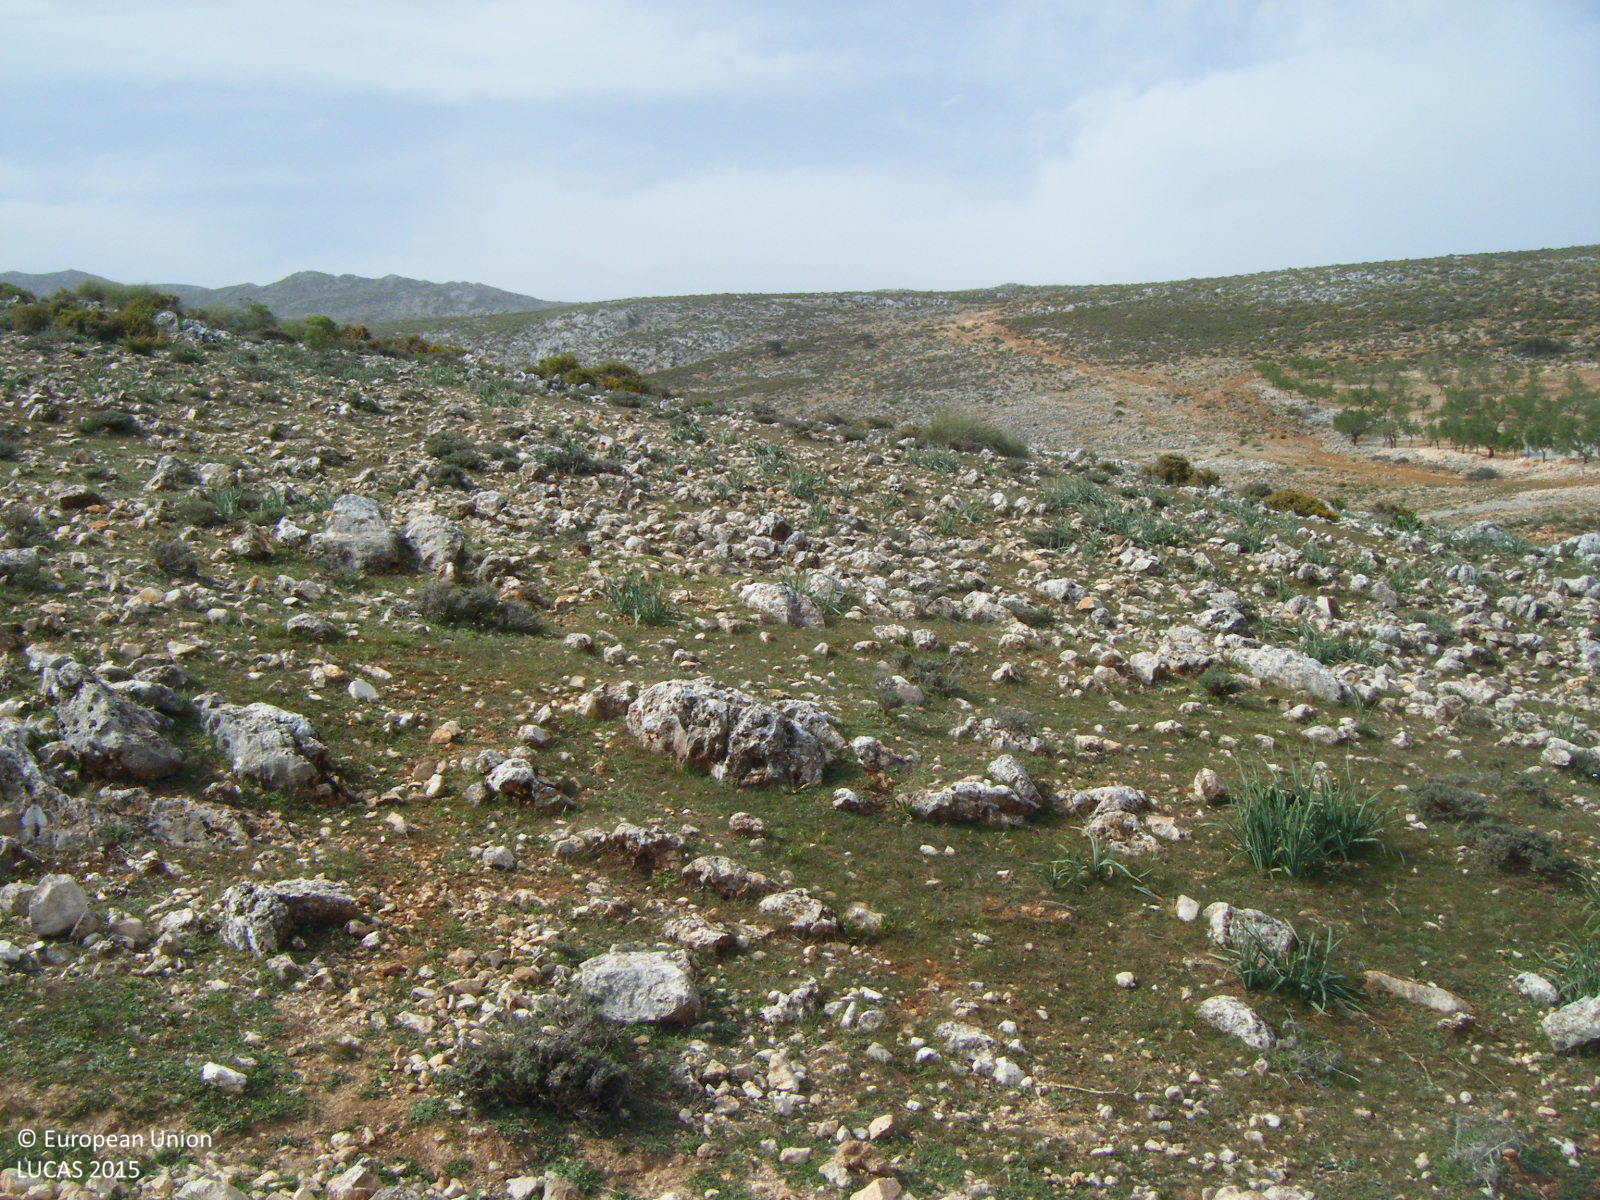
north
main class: Shrubland
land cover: Shrubland without tree cover
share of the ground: > 75 %
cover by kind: shrubs 75 %, herbaceous plants 25 %
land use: Semi-natural and natural areas not in use
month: April
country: ES
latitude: 37.0435
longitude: -4.0798
